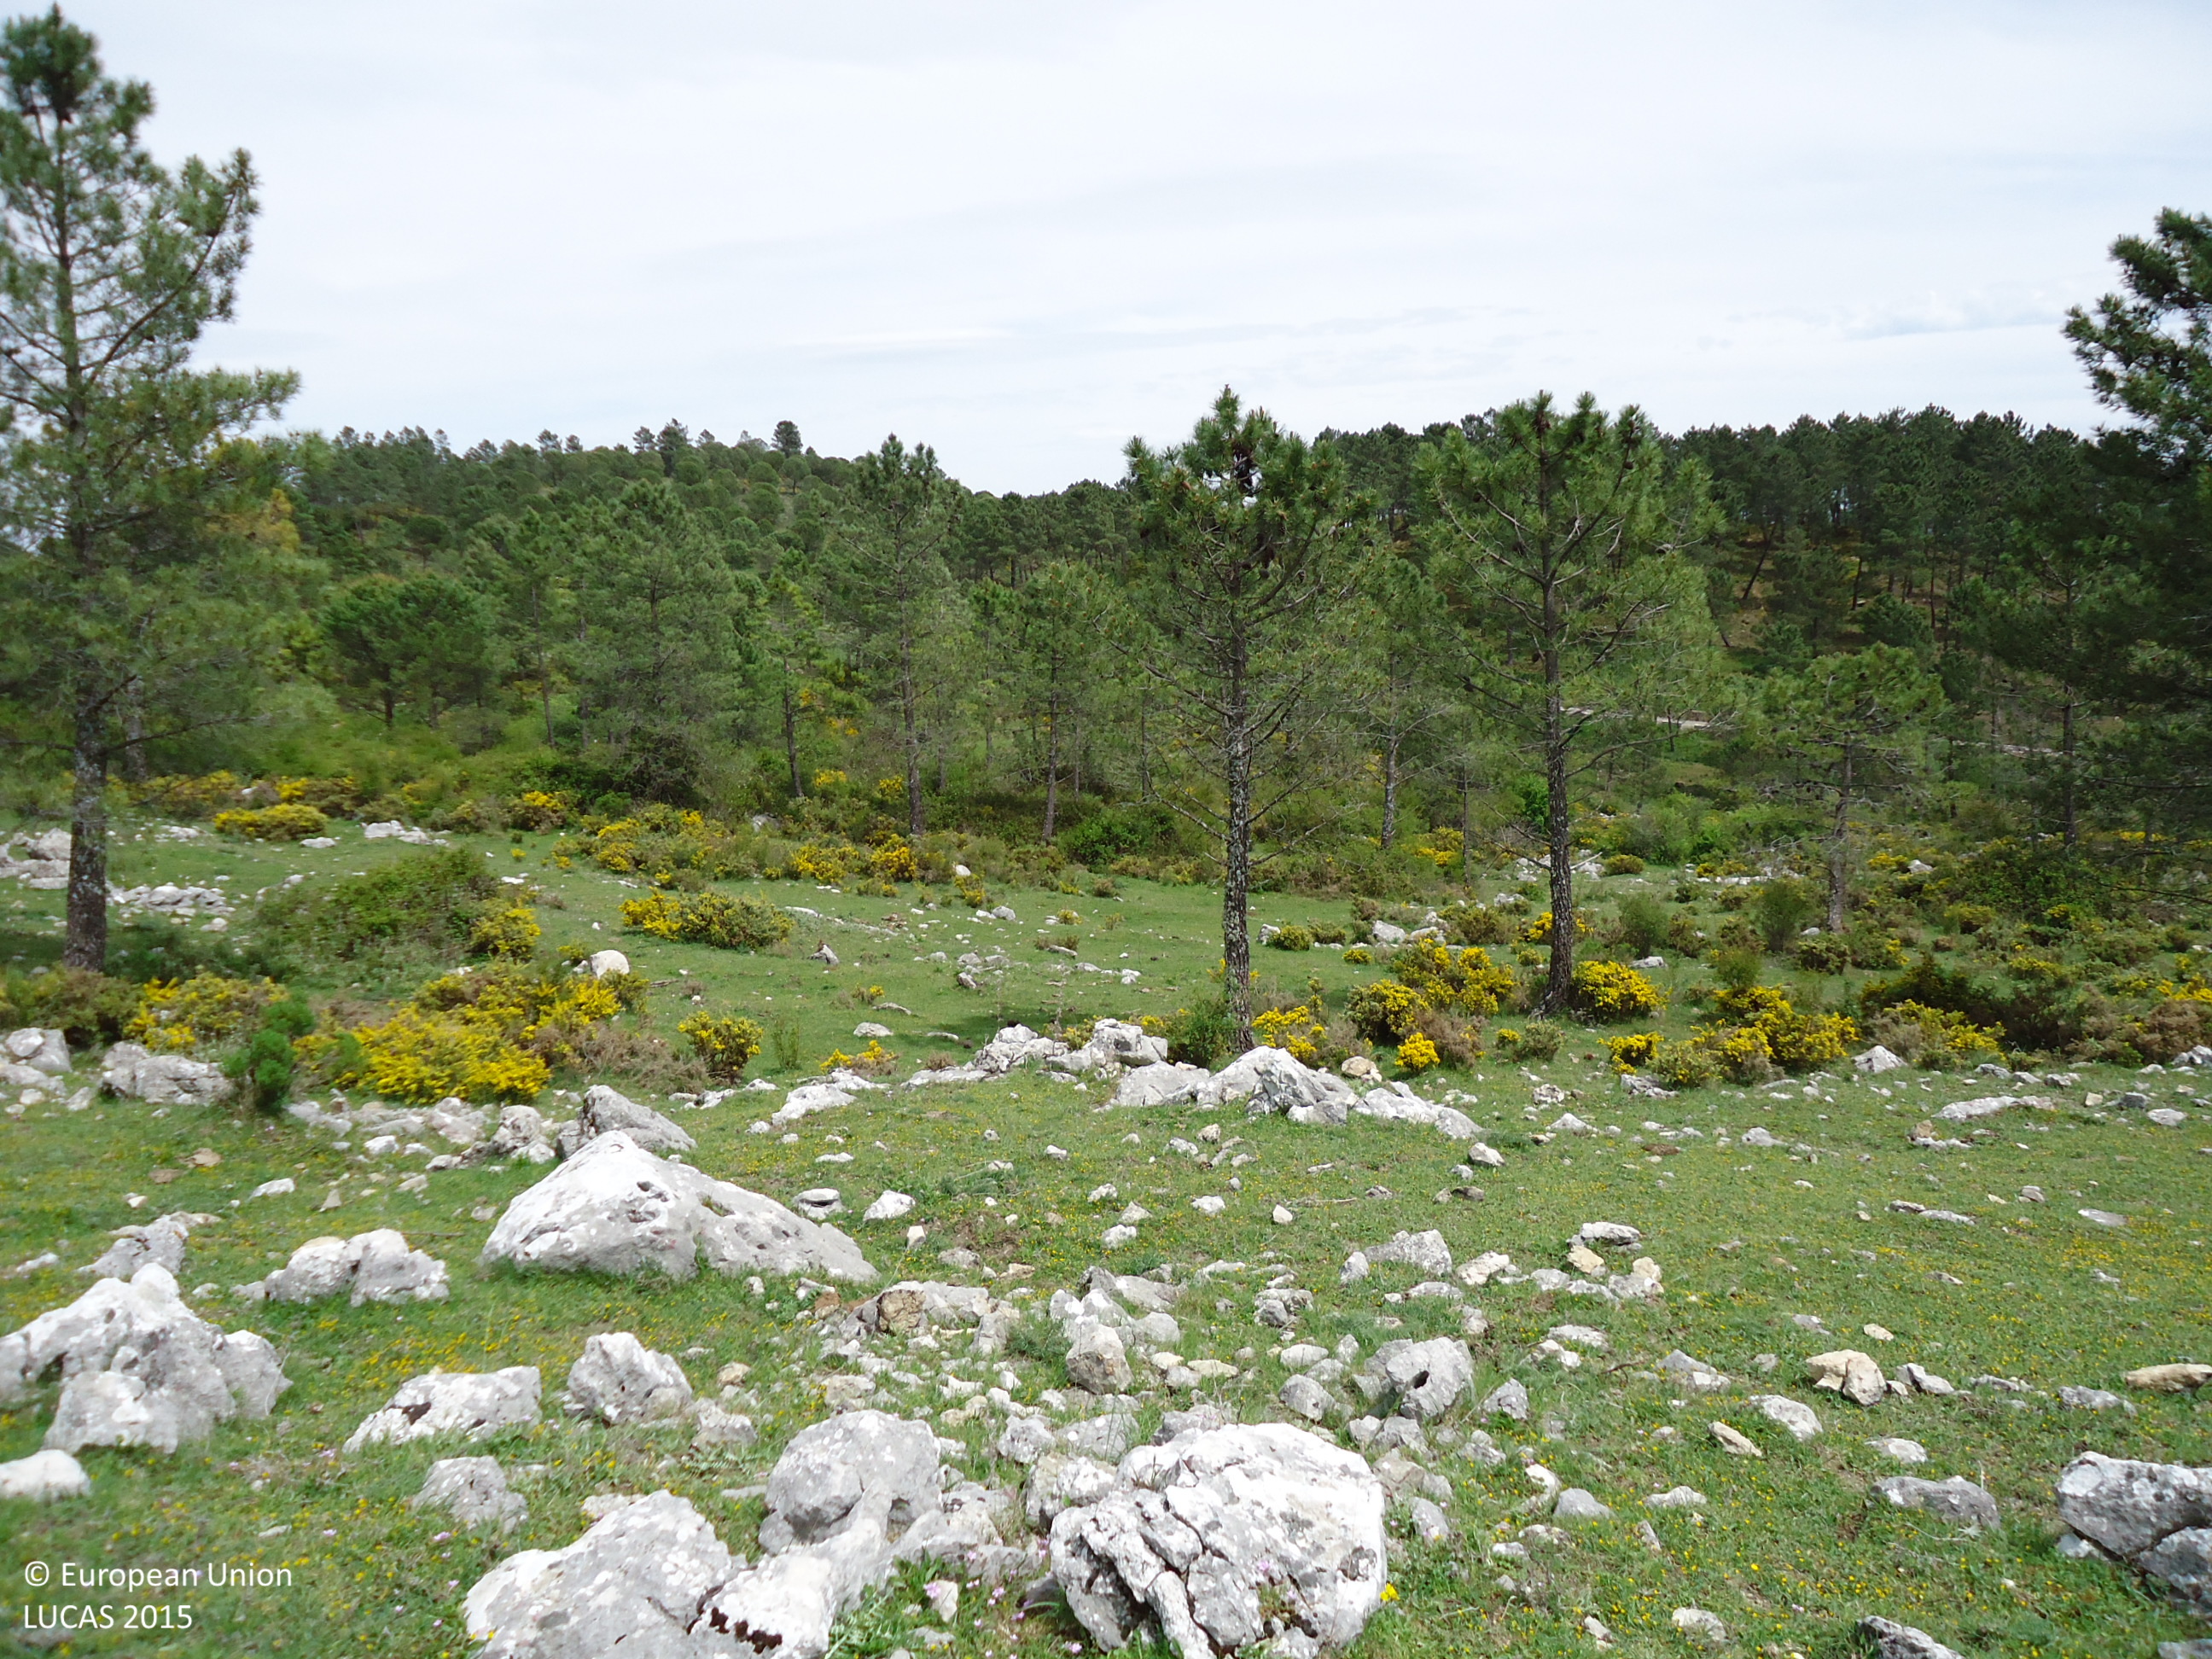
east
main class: Grassland
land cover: Grassland with sparse tree/shrub cover
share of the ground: > 75 %
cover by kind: herbaceous plants 85 %, consolidated bare surface 10 %, coniferous forest trees 5 %
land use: Agriculture (excluding fallow land and kitchen gardens)
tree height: > 5 m
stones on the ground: 10 - 25 %
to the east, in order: Grassland with sparse tree/shrub cover; Pine dominated coniferous woodland; Rock outcrops; Pine dominated coniferous woodland; Grassland with sparse tree/shrub cover; Fences; Grassland with sparse tree/shrub cover; Paved roads, cycling and walking lanes; Grassland with sparse tree/shrub cover; Fences; Pine dominated coniferous woodland
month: May
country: ES
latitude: 36.7640
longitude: -5.3836
